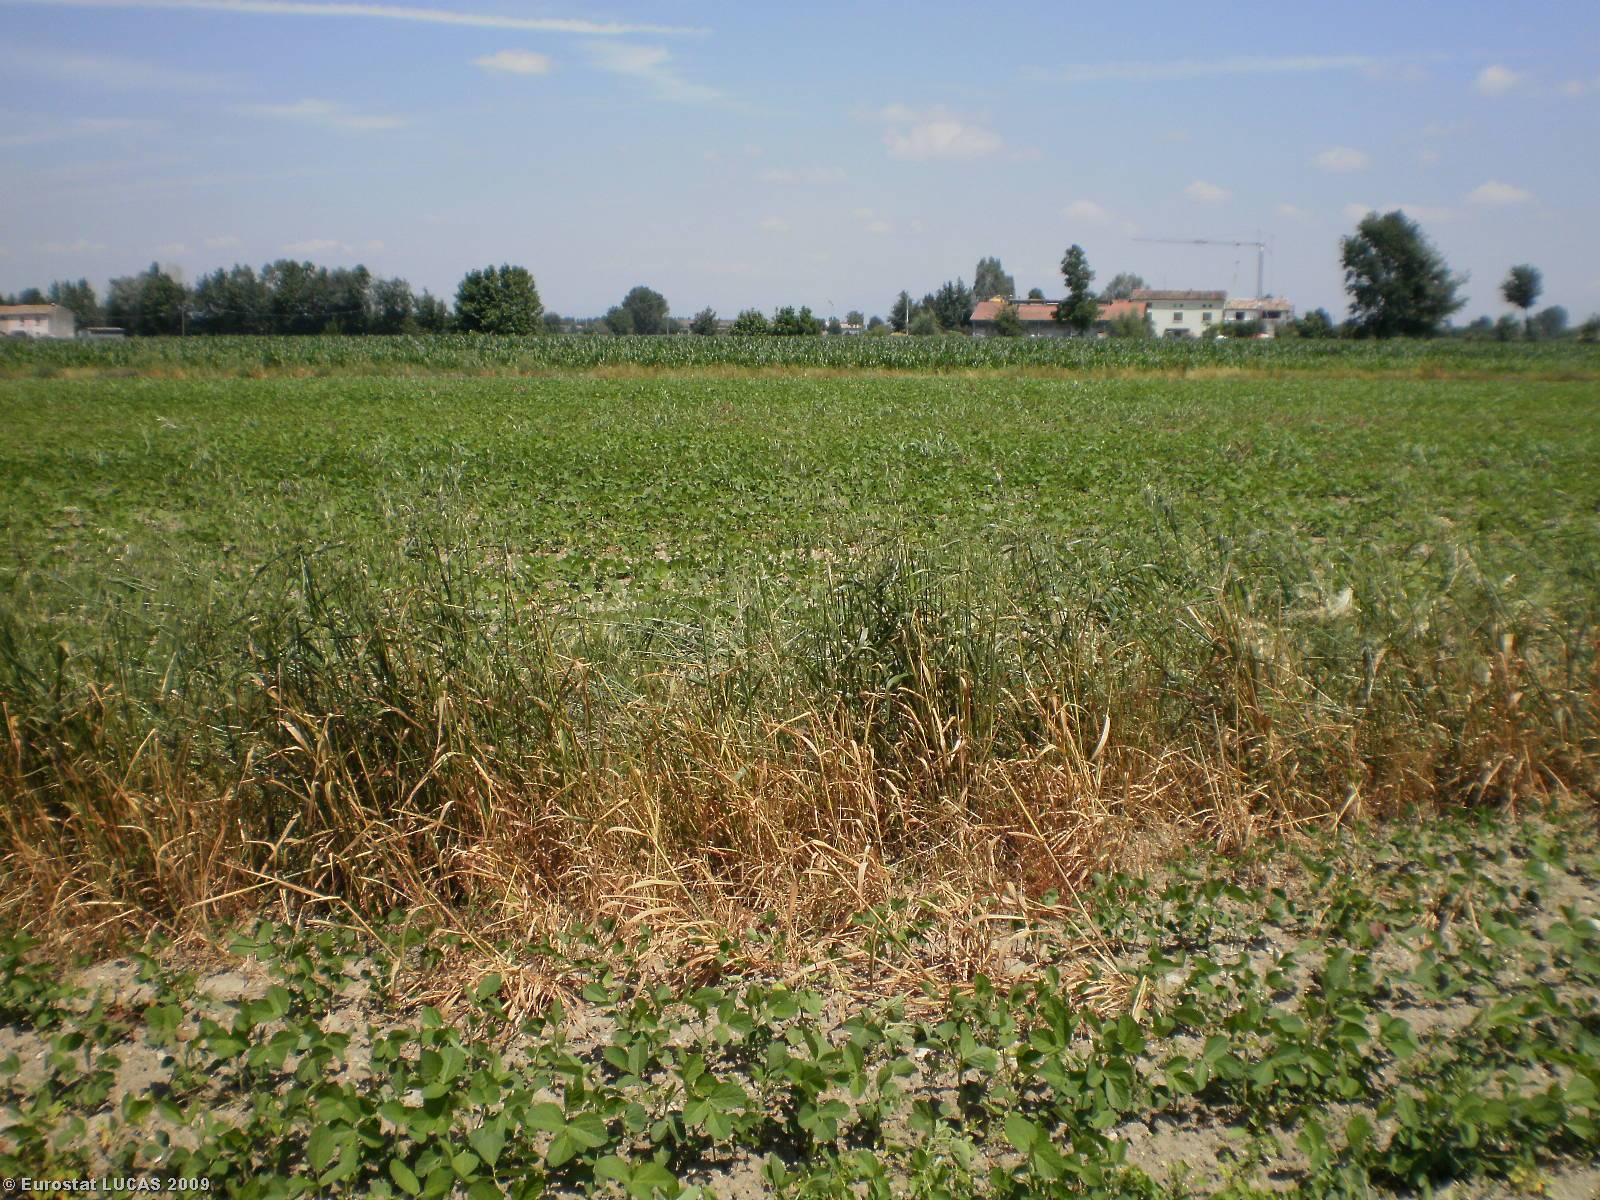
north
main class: Cropland
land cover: Soya
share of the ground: 50 - 75 %
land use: Agriculture (excluding fallow land and kitchen gardens)
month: May
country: IT
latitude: 45.2692
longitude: 10.4453
